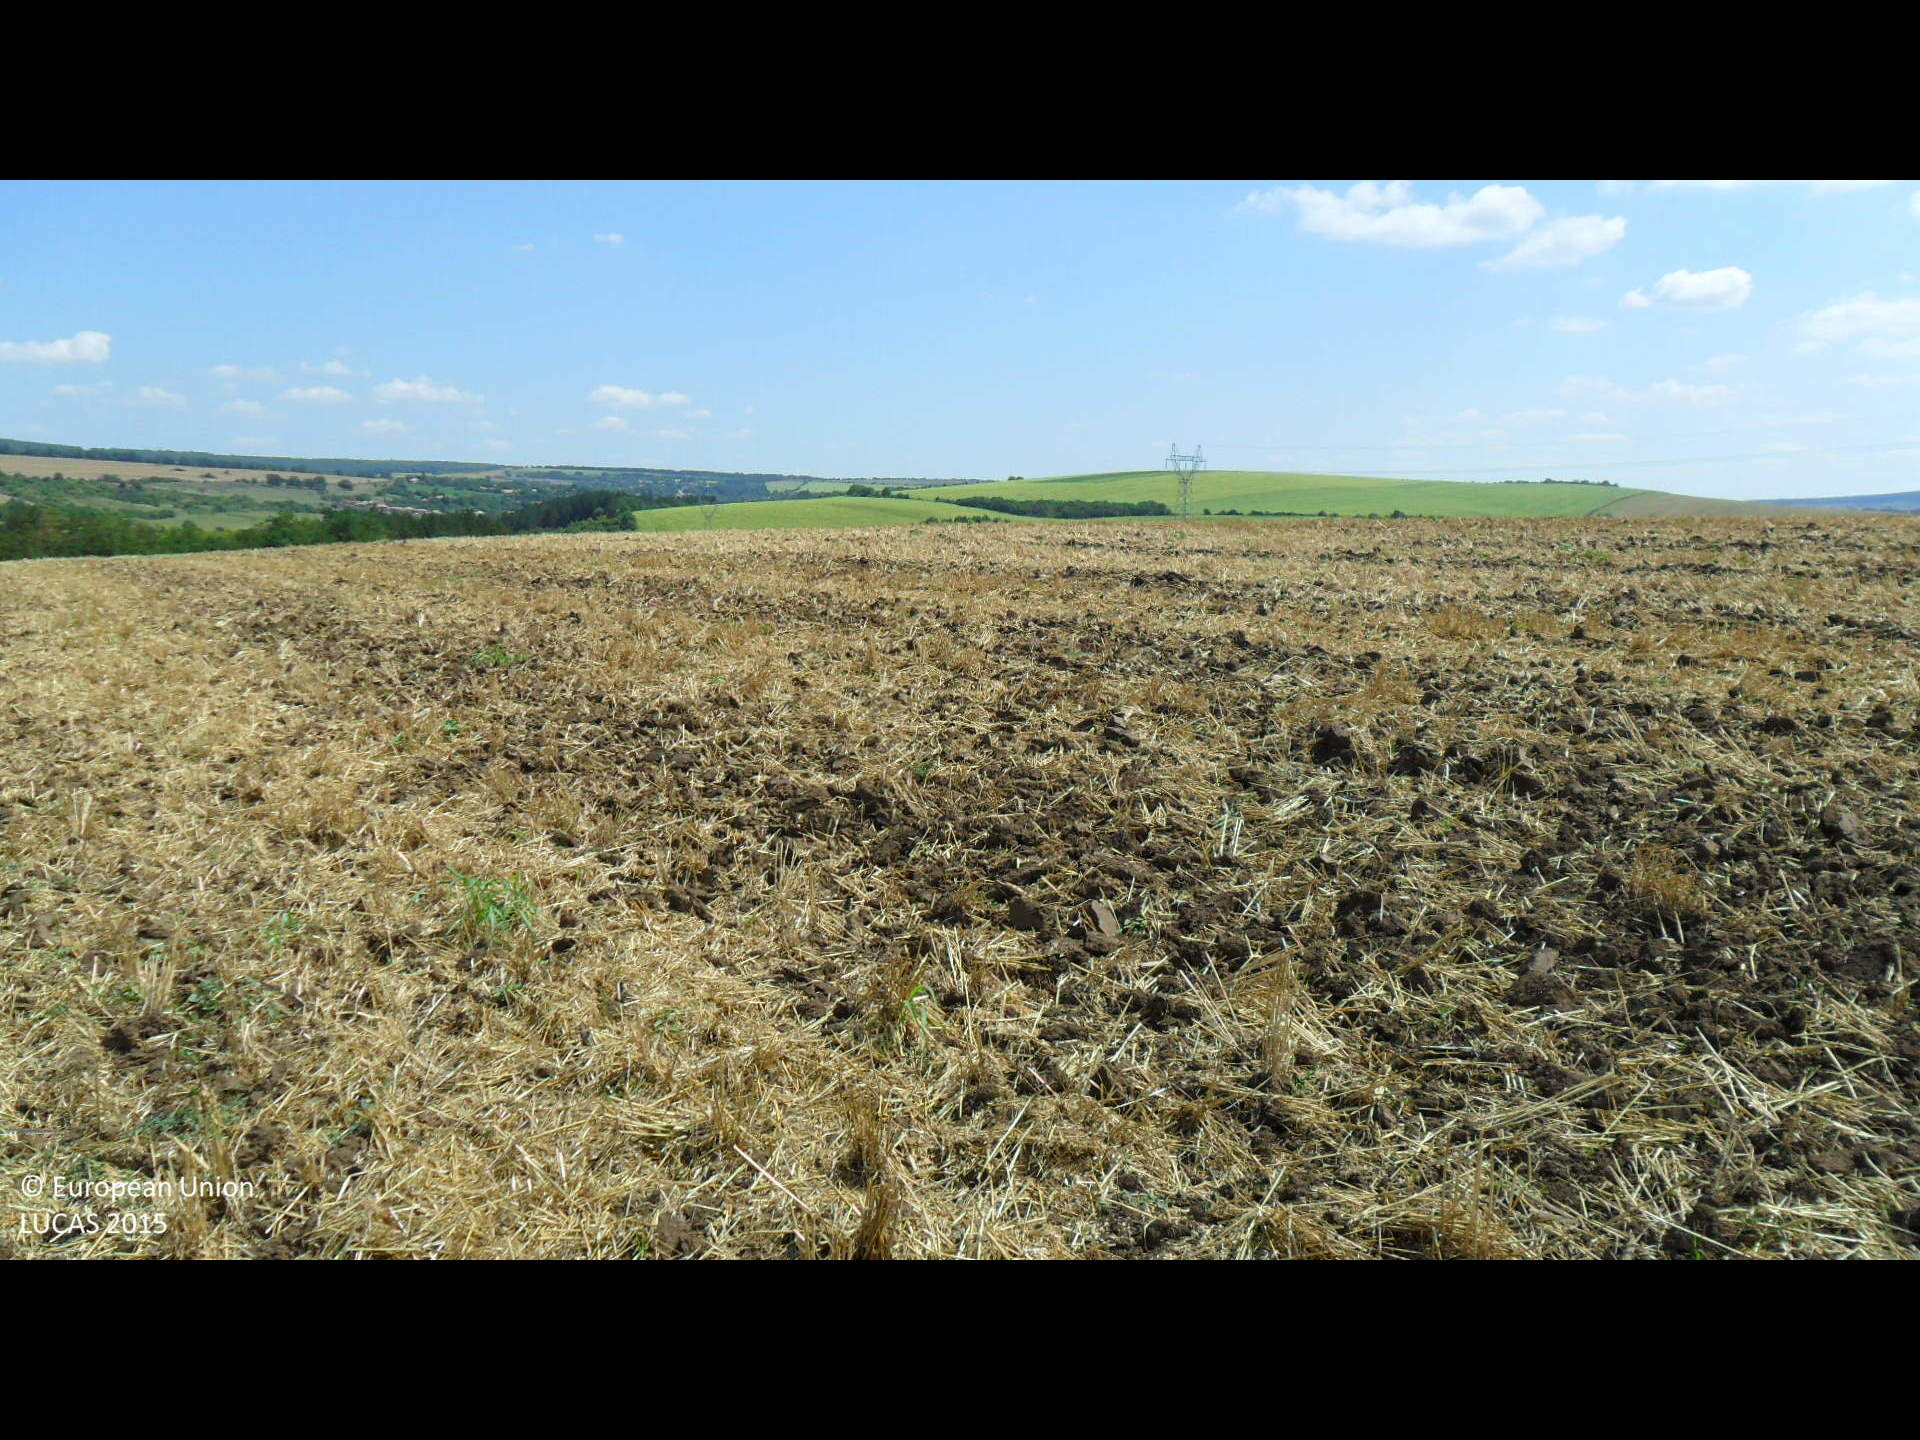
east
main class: Cropland
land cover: Common wheat
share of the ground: 25 - 50 %
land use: Agriculture (excluding fallow land and kitchen gardens)
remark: Harvested field
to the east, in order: Common wheat; Electric lines; Common wheat; Grassland without tree/shrub cover
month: August
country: BG
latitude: 43.4435
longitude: 26.3737
